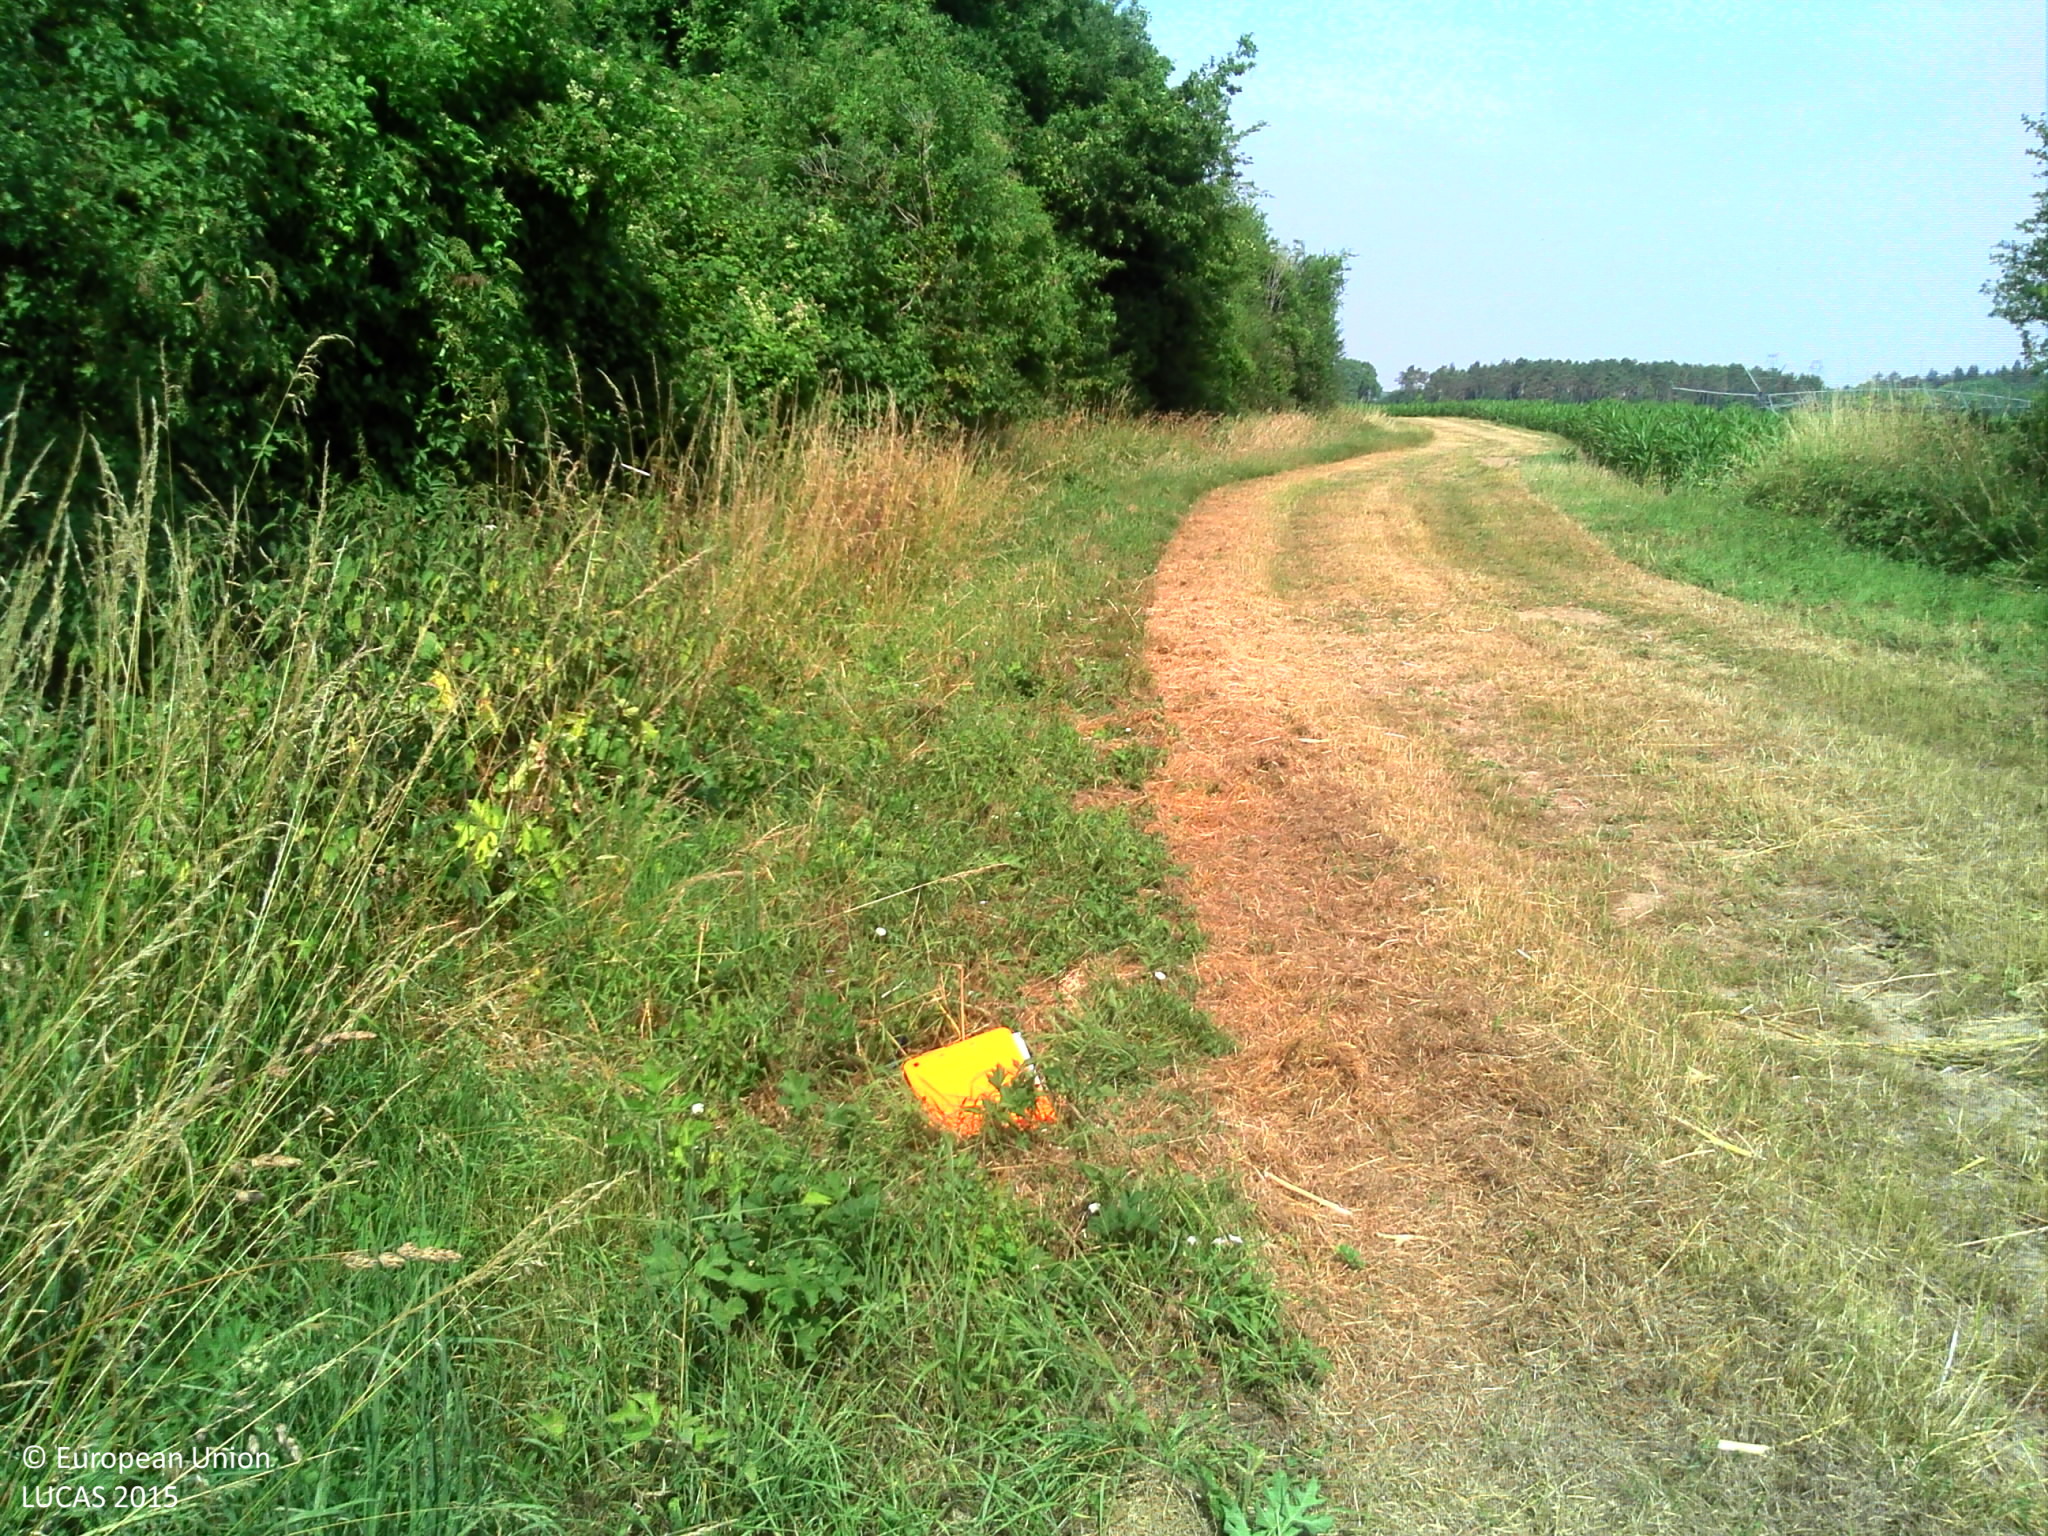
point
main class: Cropland
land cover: Rape and turnip rape
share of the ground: > 75 %
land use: Agriculture (excluding fallow land and kitchen gardens)
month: July
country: FR
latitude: 47.8249
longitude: 2.7927
